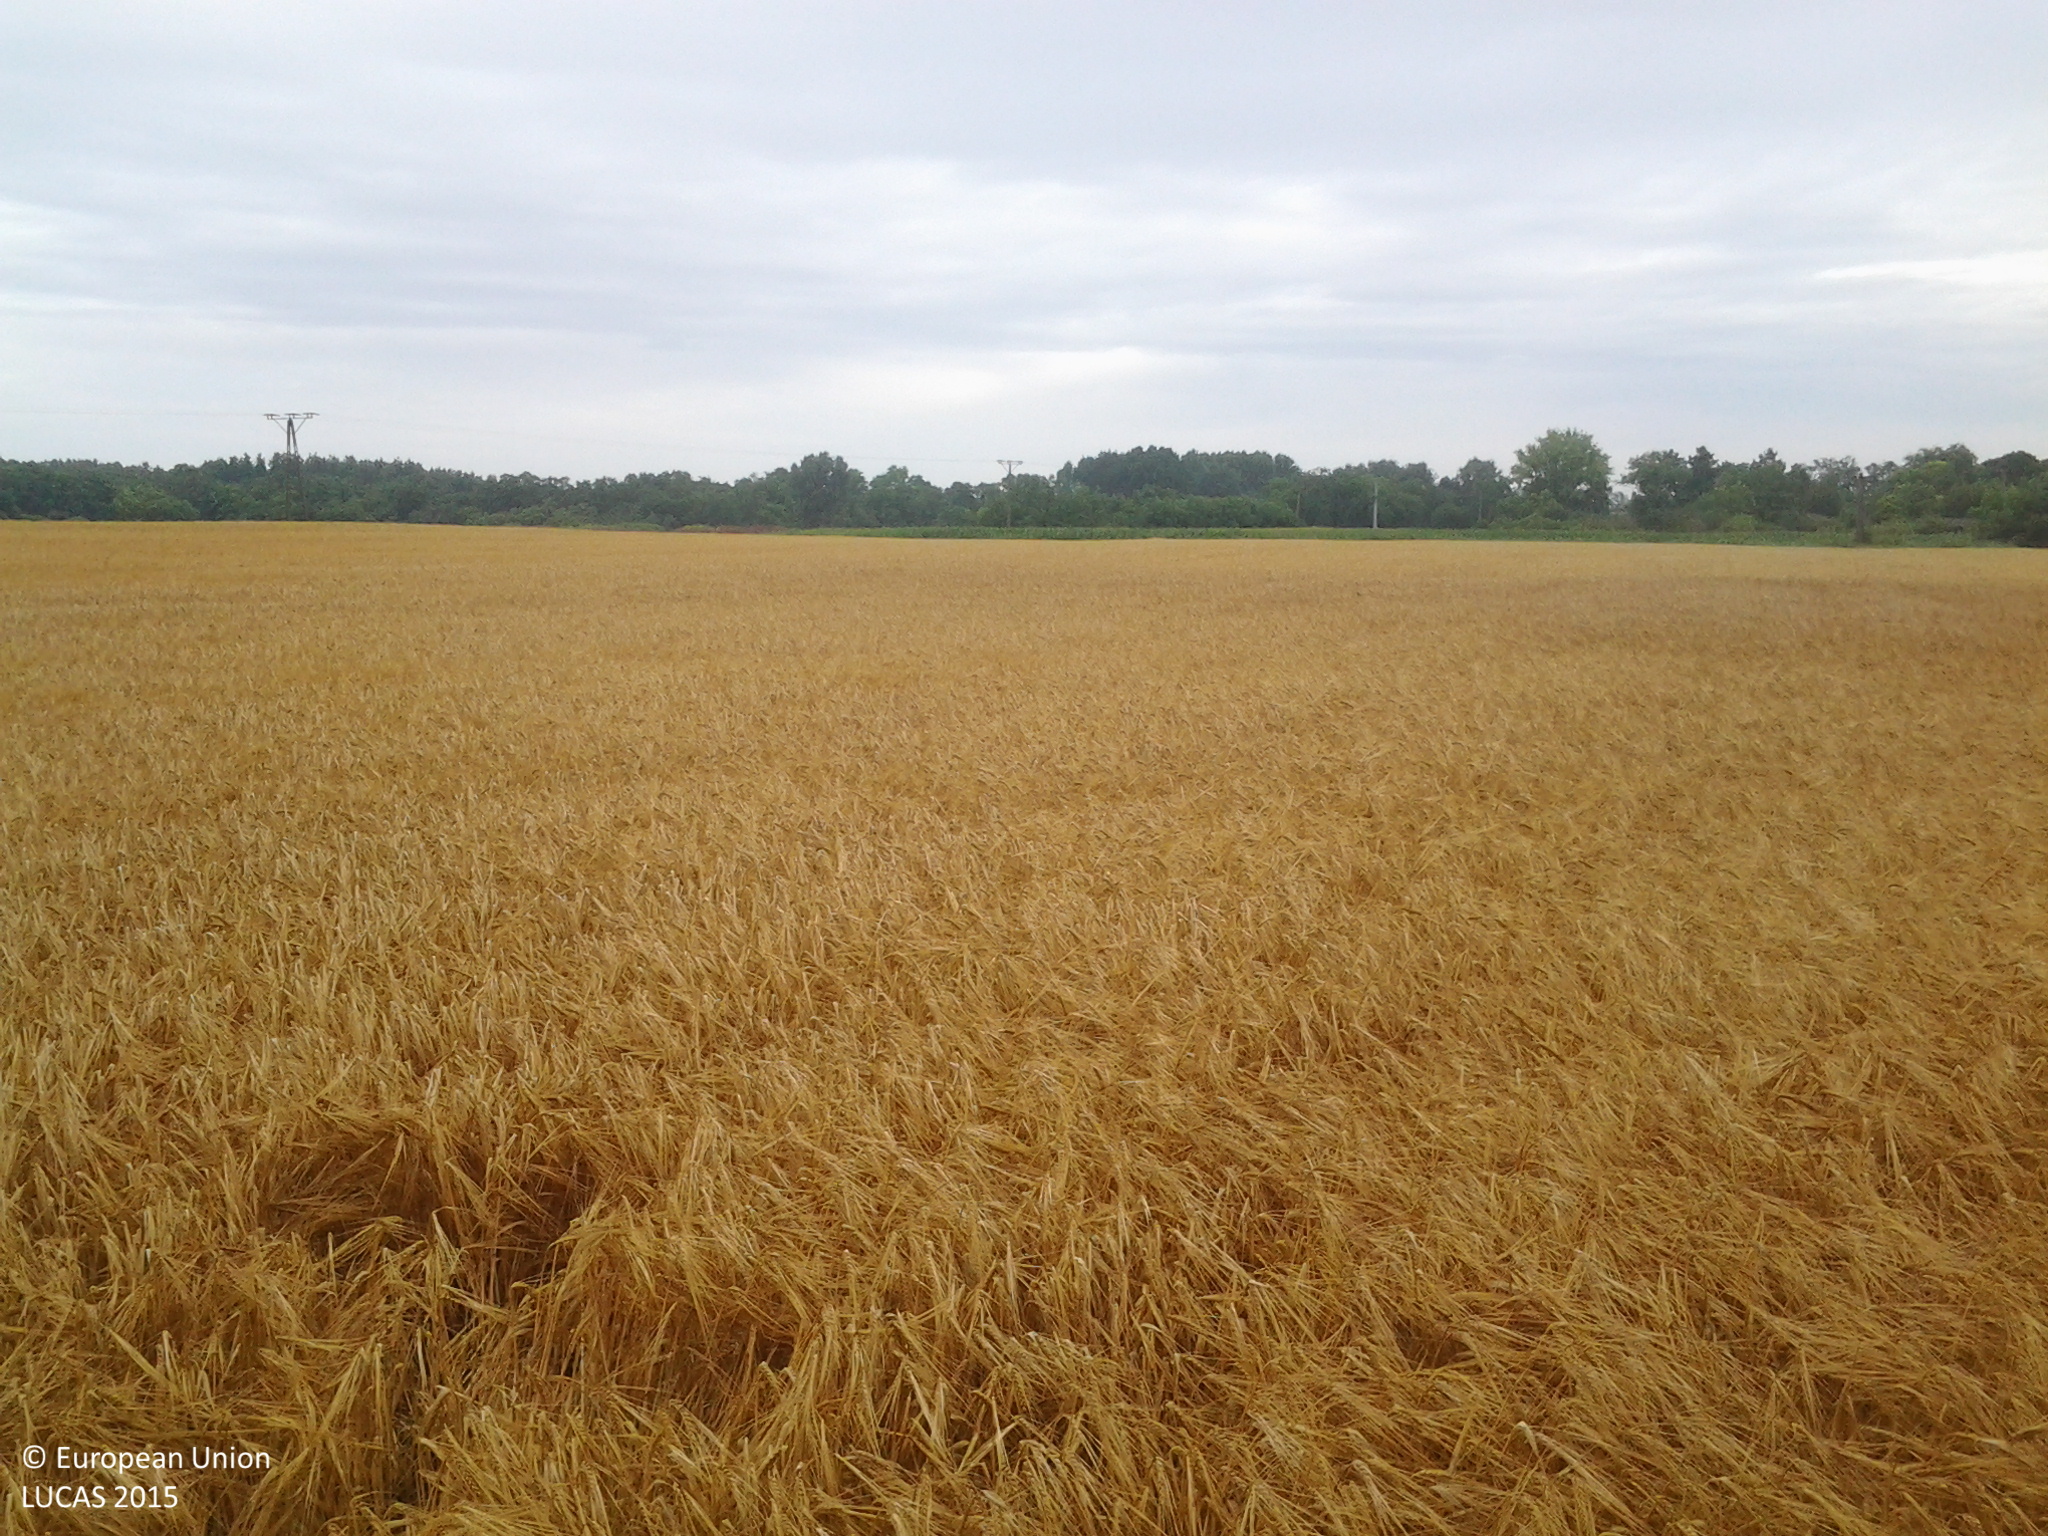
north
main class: Cropland
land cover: Barley
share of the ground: > 75 %
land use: Agriculture (excluding fallow land and kitchen gardens)
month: July
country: HU
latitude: 46.9437
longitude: 19.0675
